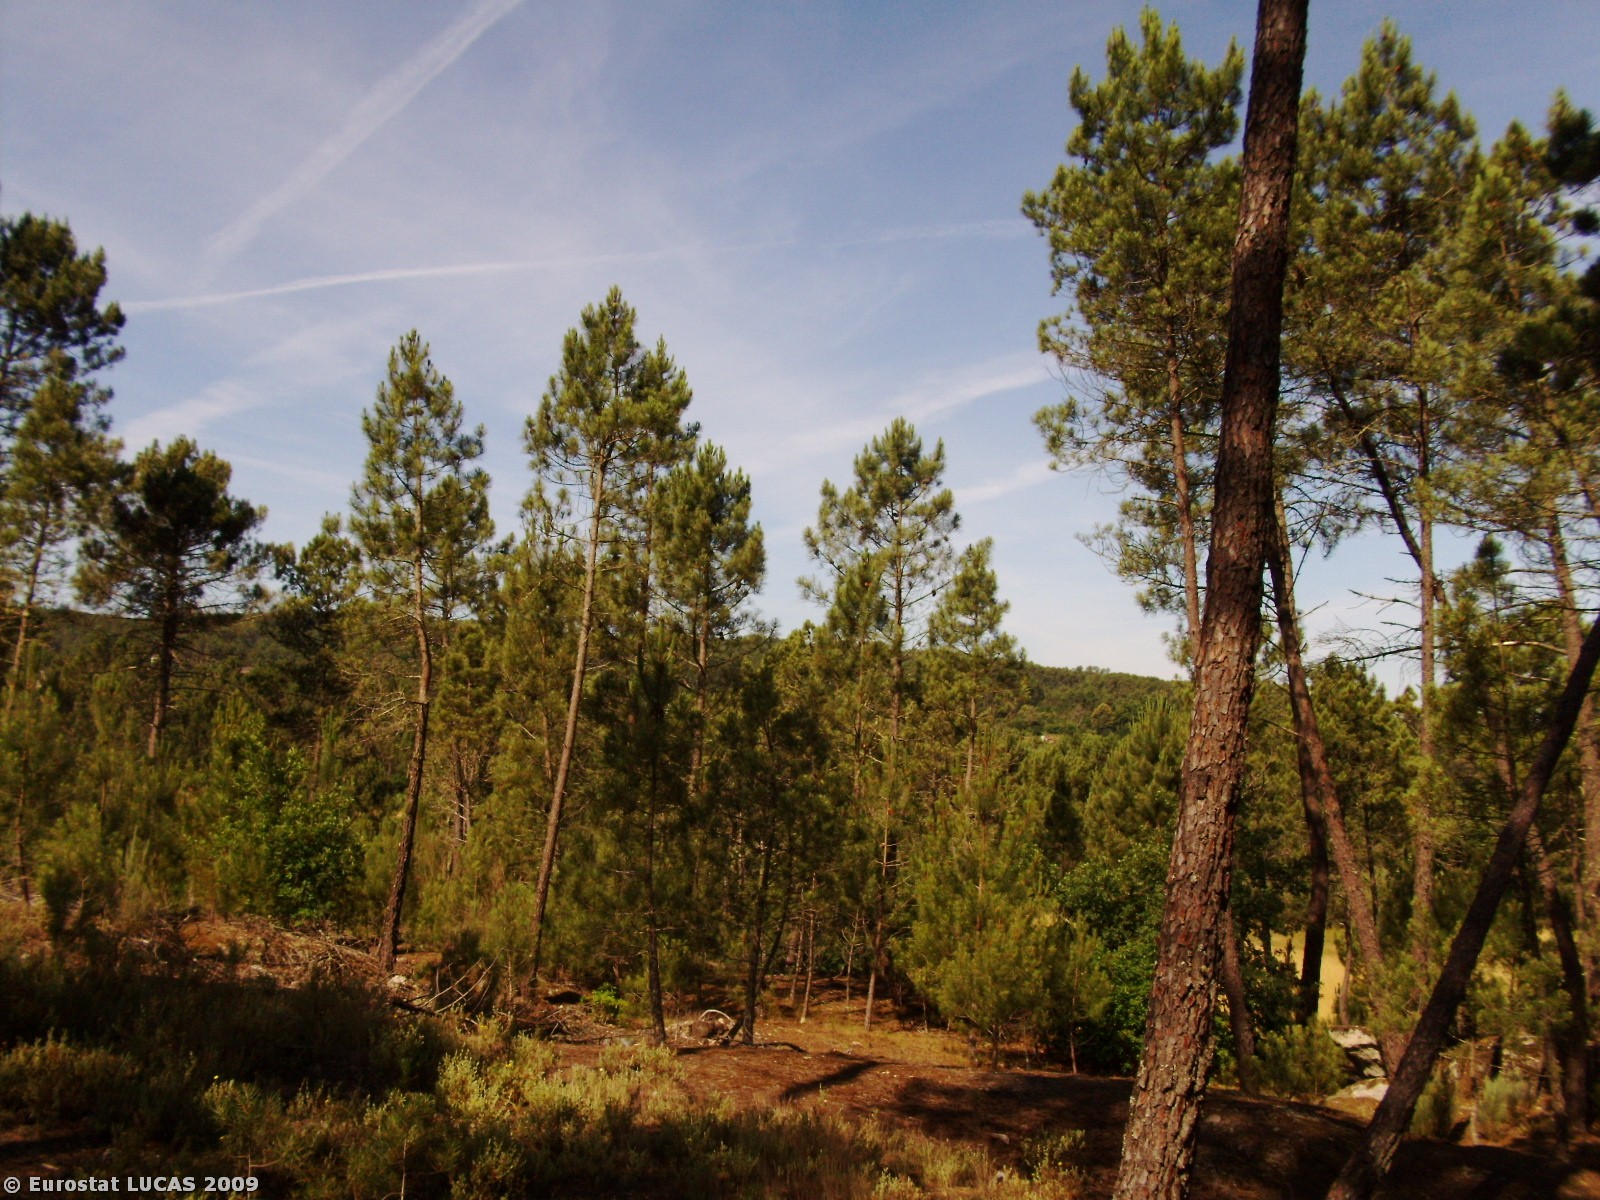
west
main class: Woodland
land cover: Coniferous woodland
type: coniferous forest of the mediterranean region
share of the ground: > 75 %
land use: Forestry
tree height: > 5 m
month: July
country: PT
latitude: 40.7686
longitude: -7.6897
